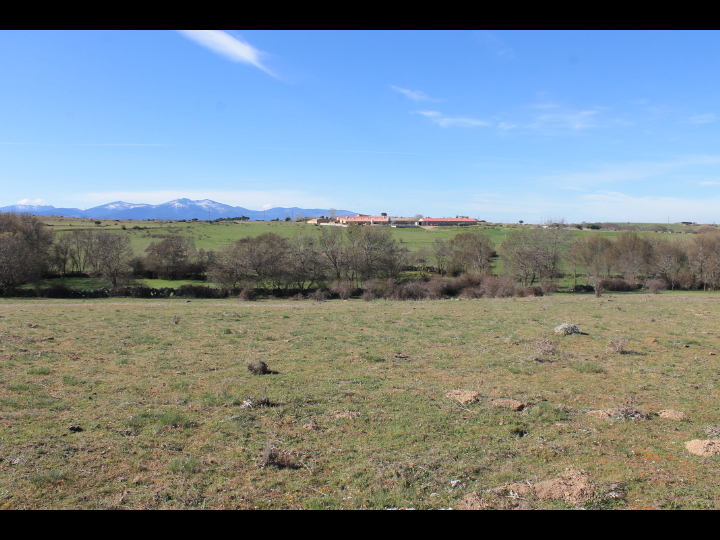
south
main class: Grassland
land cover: Grassland without tree/shrub cover
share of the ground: > 75 %
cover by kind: herbaceous plants 95 %, unconsolidated bare surface 5 %
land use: Agriculture (excluding fallow land and kitchen gardens)
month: April
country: ES
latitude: 40.9896
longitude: -4.0643
